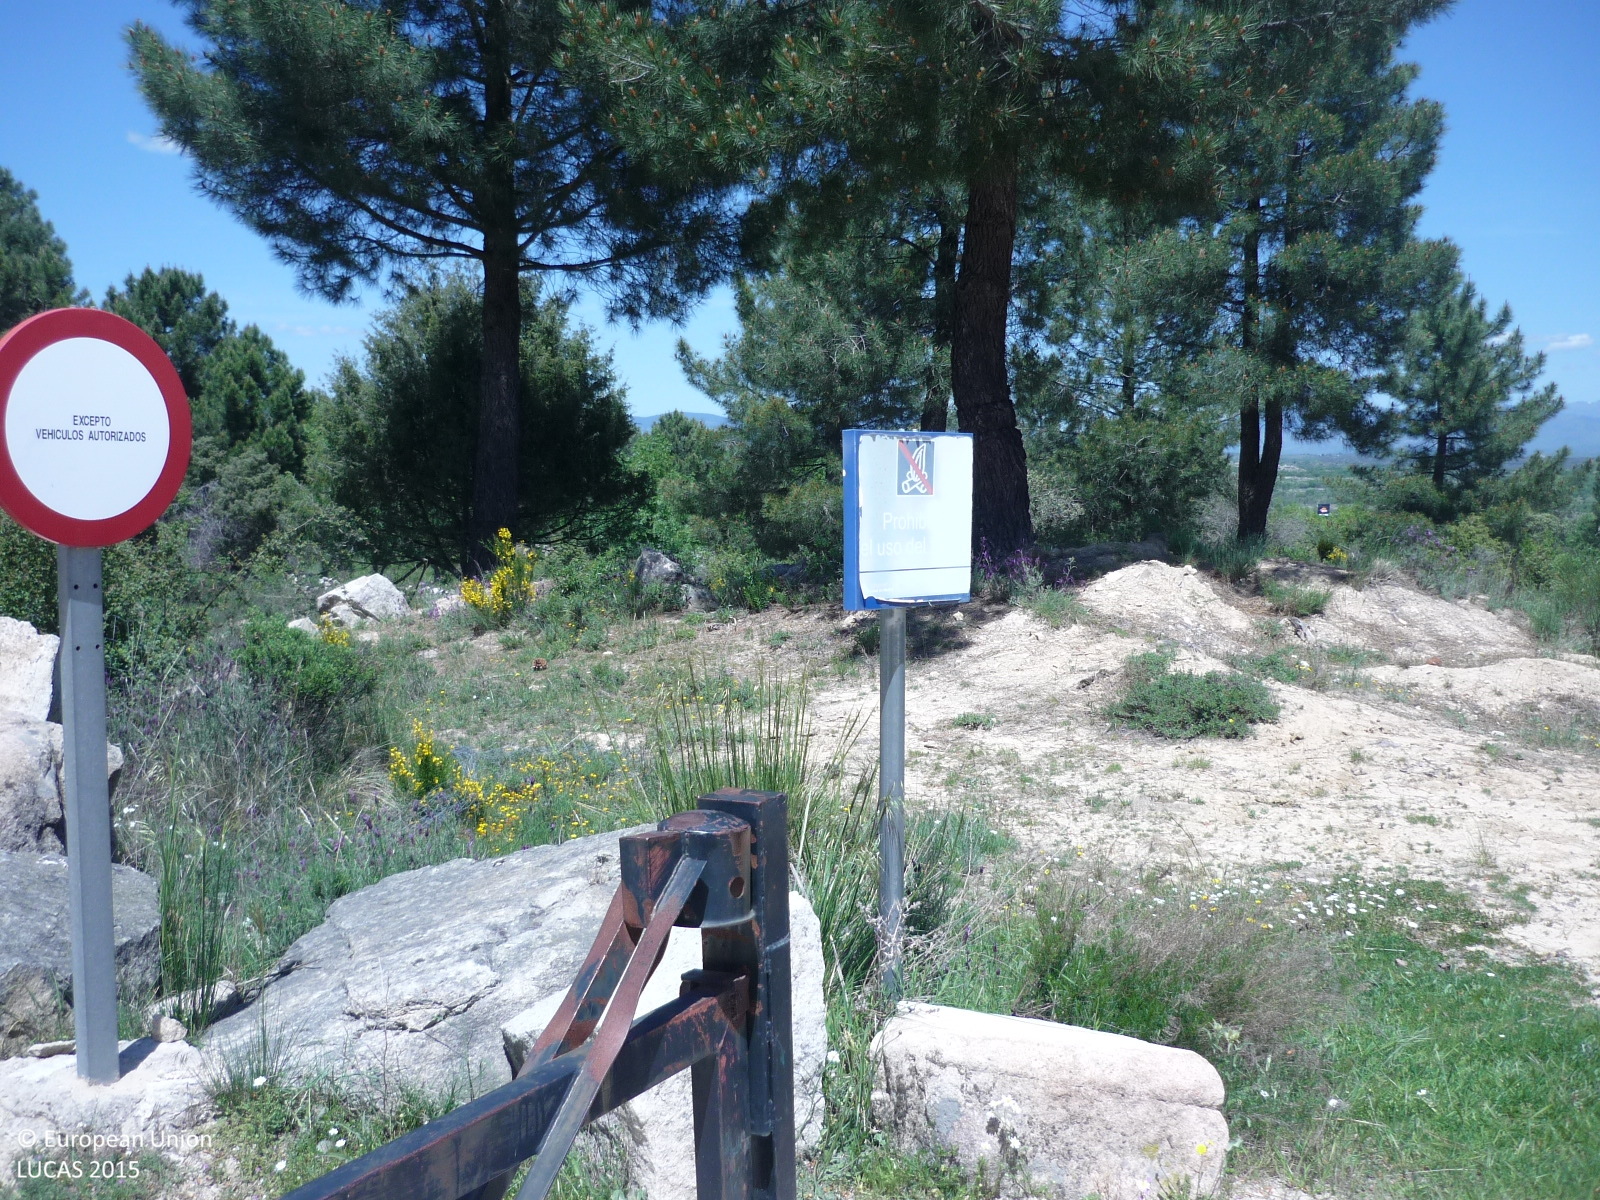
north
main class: Woodland
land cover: Broadleaved woodland
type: broadleaved evergreen forest
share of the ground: 25 - 50 %
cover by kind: herbaceous plants 60 %, broadleaved forest trees 40 %
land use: Forestry
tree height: > 5 m
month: May
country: ES
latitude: 40.9037
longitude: -3.6353
